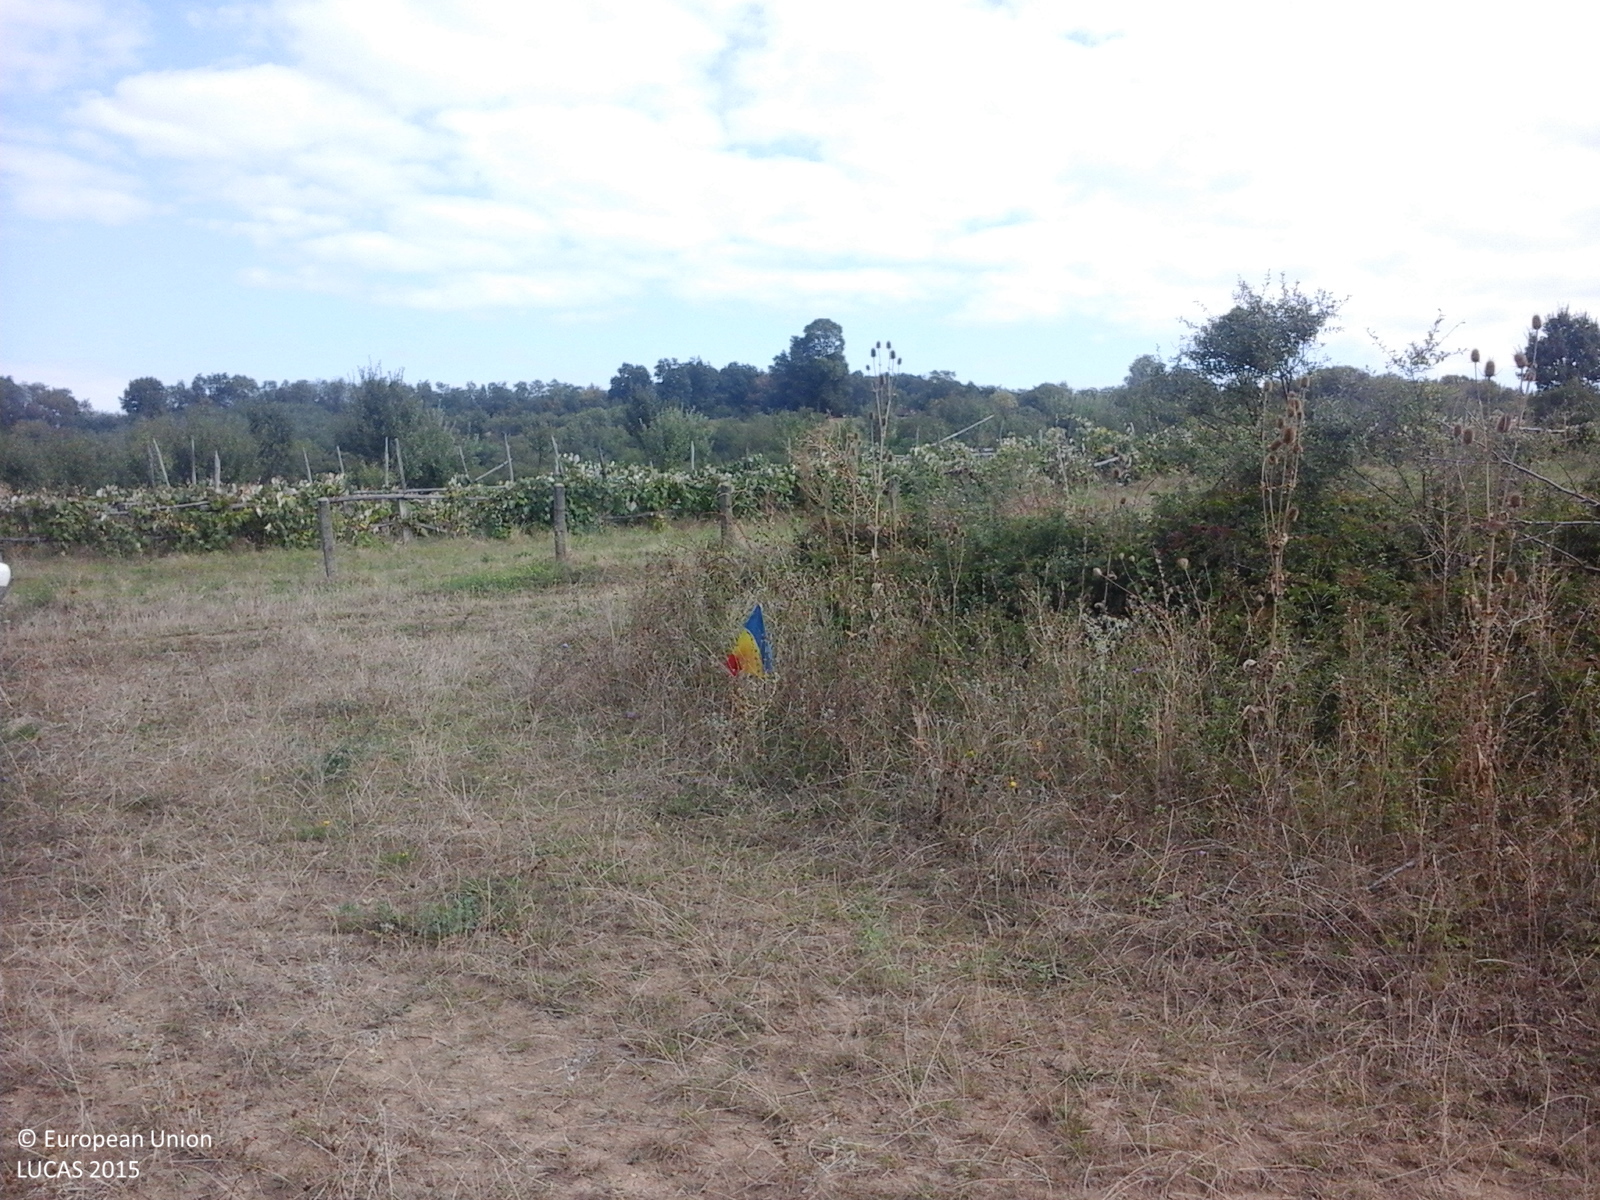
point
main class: Grassland
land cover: Spontaneously vegetated surfaces
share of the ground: > 75 %
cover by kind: herbaceous plants 100 %
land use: Fallow land
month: September
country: RO
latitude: 47.4571
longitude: 23.2405
